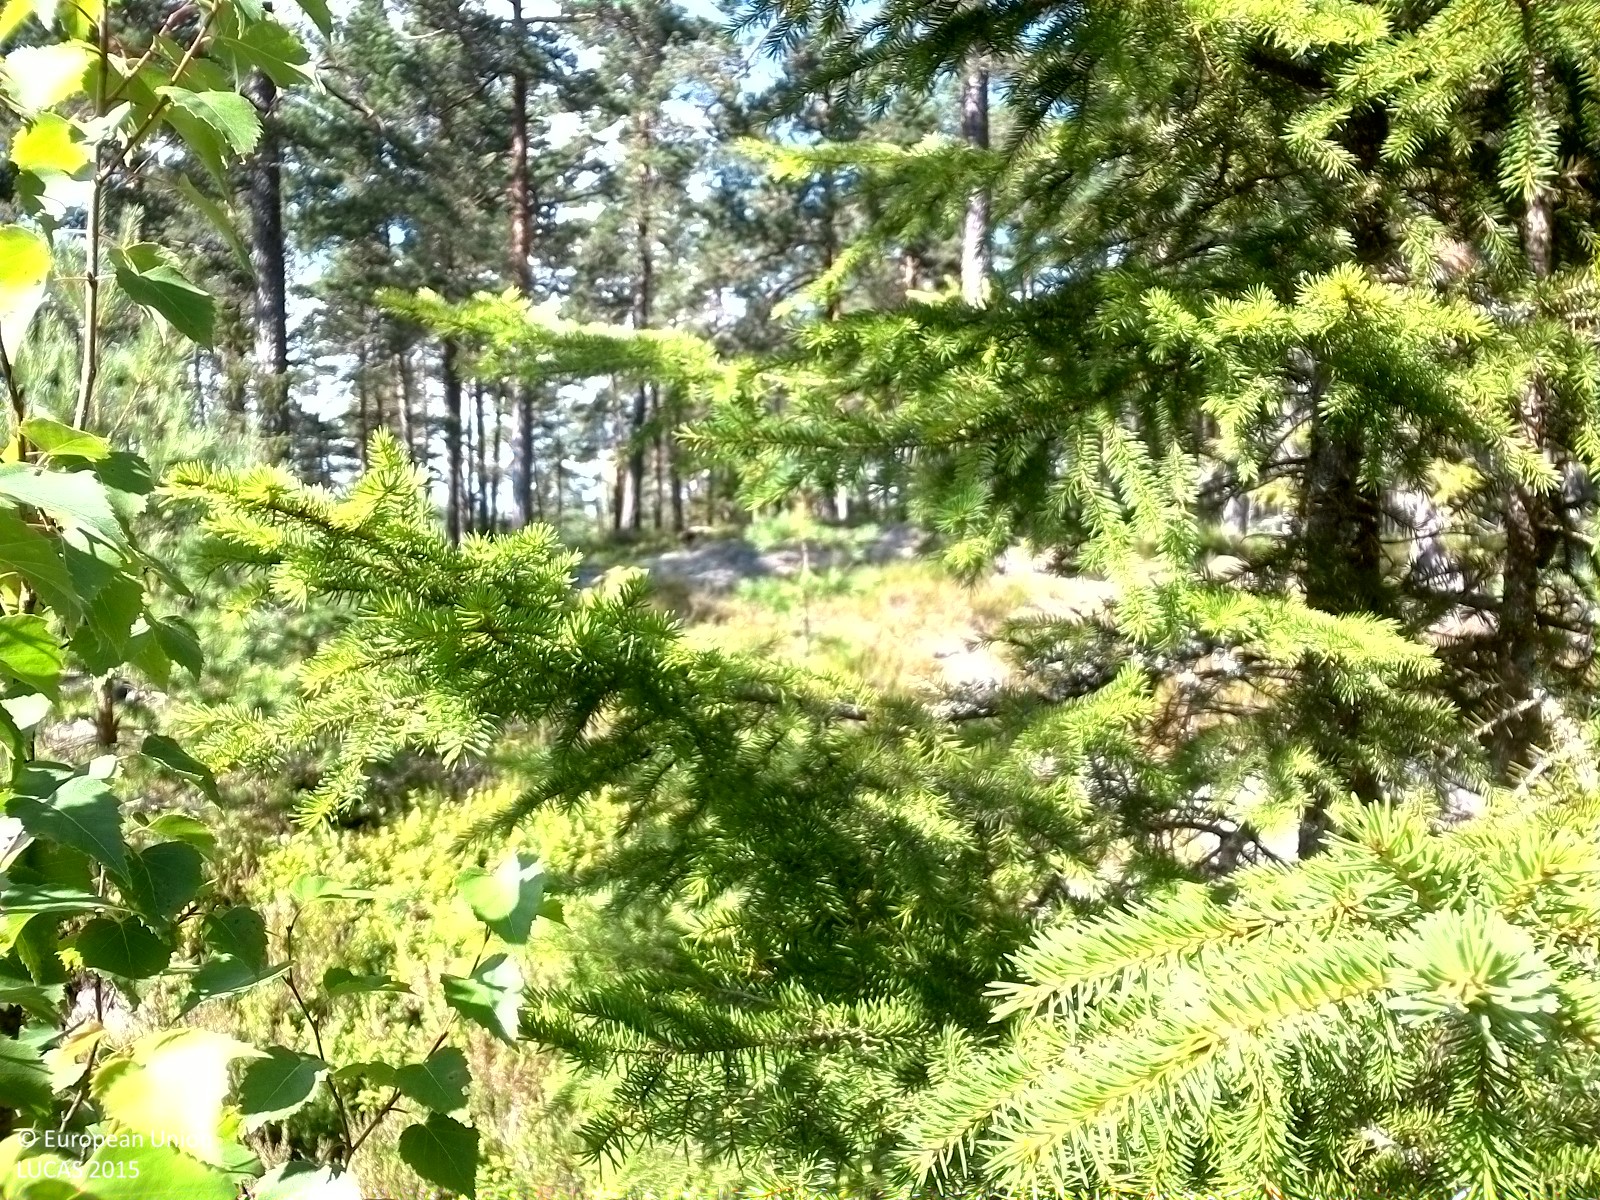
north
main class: Woodland
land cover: Pine dominated coniferous woodland
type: boreal forest
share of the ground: 50 - 75 %
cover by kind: coniferous forest trees 55 %, herbaceous plants 25 %, shrubs 15 %, lichens and mosses 5 %
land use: Forestry
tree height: < 5 m
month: August
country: SE
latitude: 58.9959
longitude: 15.3708
